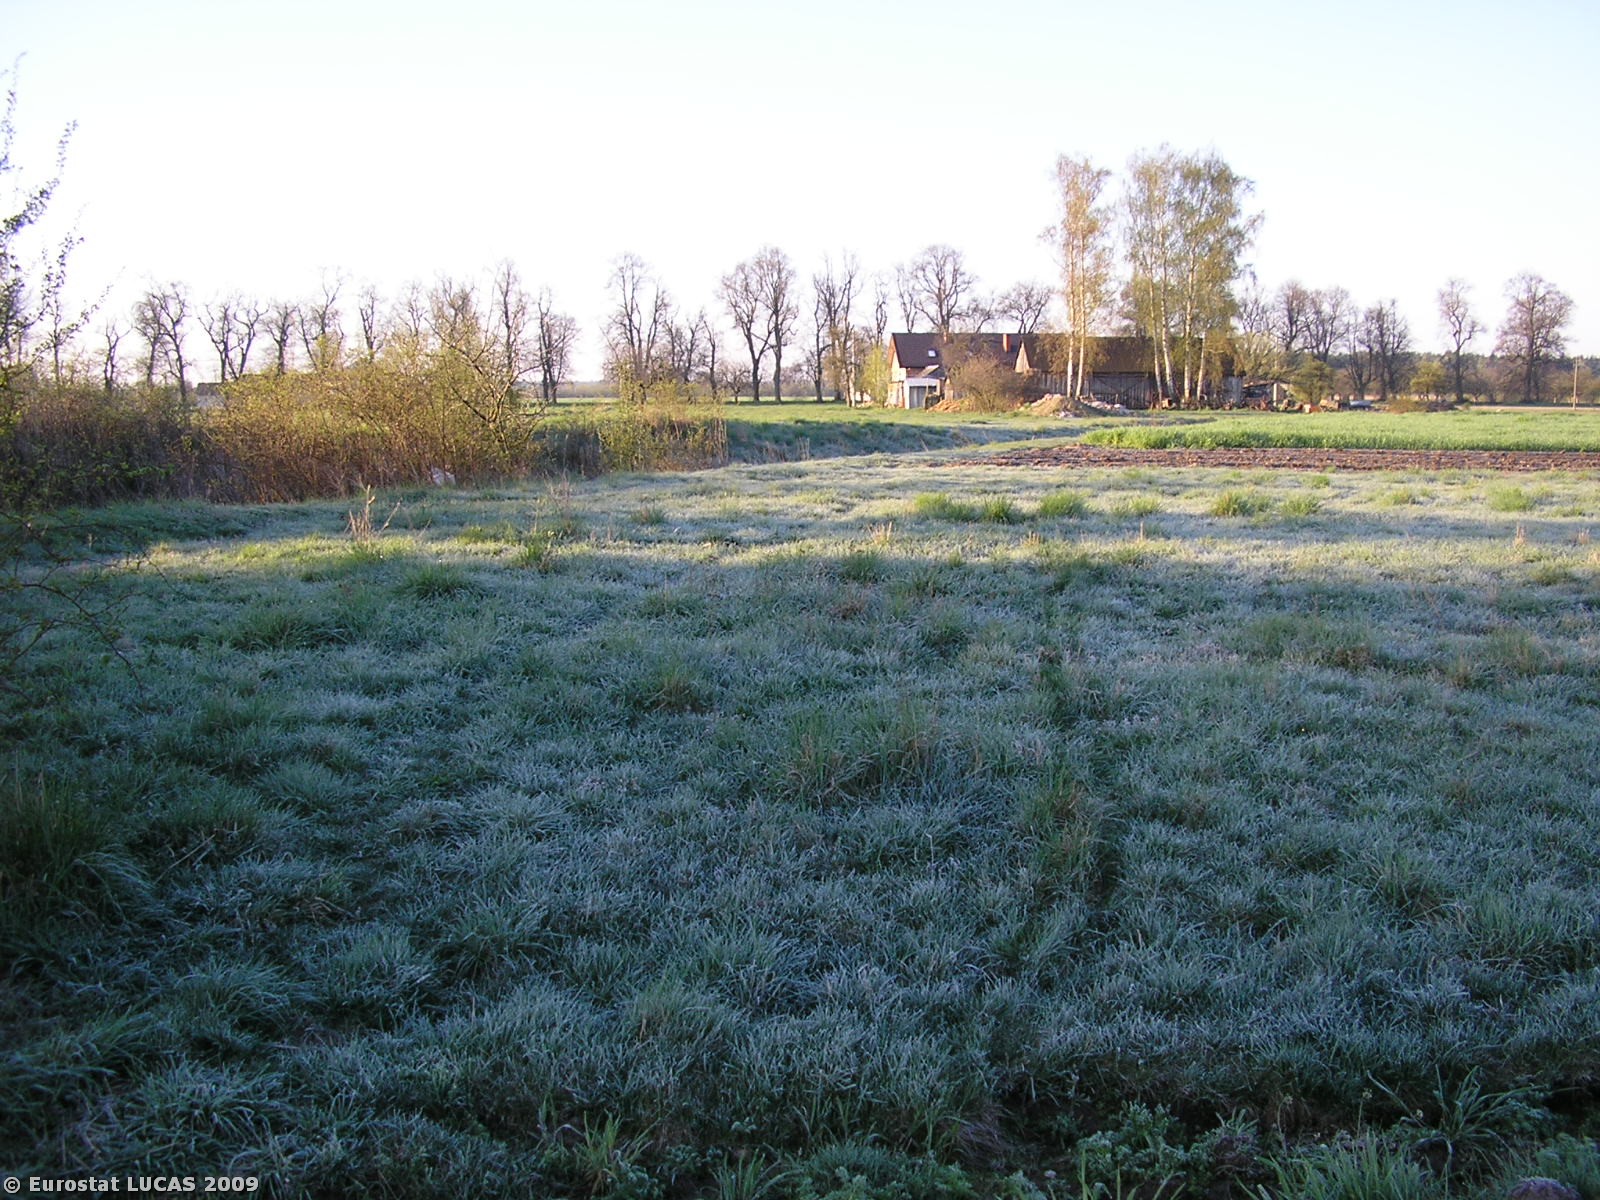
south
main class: Cropland
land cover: Other root crops
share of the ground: < 10 %
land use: Agriculture (excluding fallow land and kitchen gardens)
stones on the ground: < 10 %
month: April
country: PL
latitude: 52.0737
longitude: 20.0860
